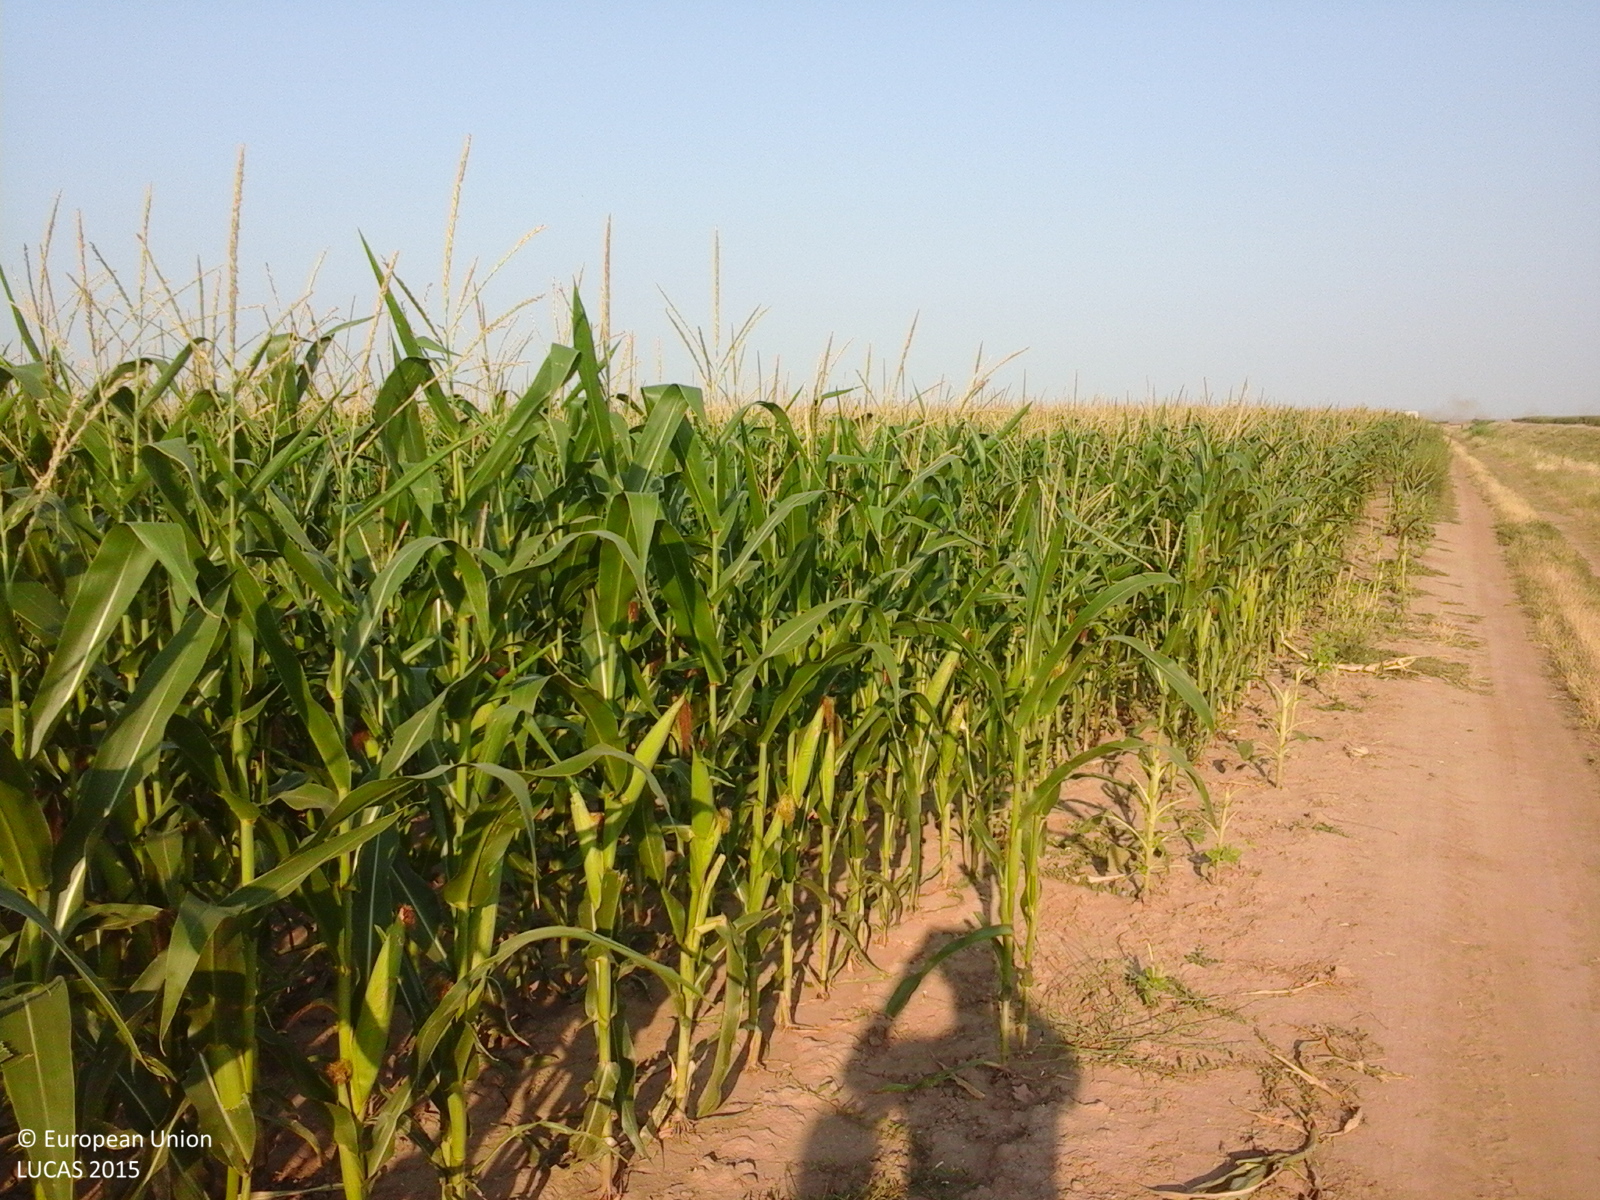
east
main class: Cropland
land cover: Maize
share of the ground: > 75 %
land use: Agriculture (excluding fallow land and kitchen gardens)
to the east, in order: Maize
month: July
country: RO
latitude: 44.7770
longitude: 27.2102
